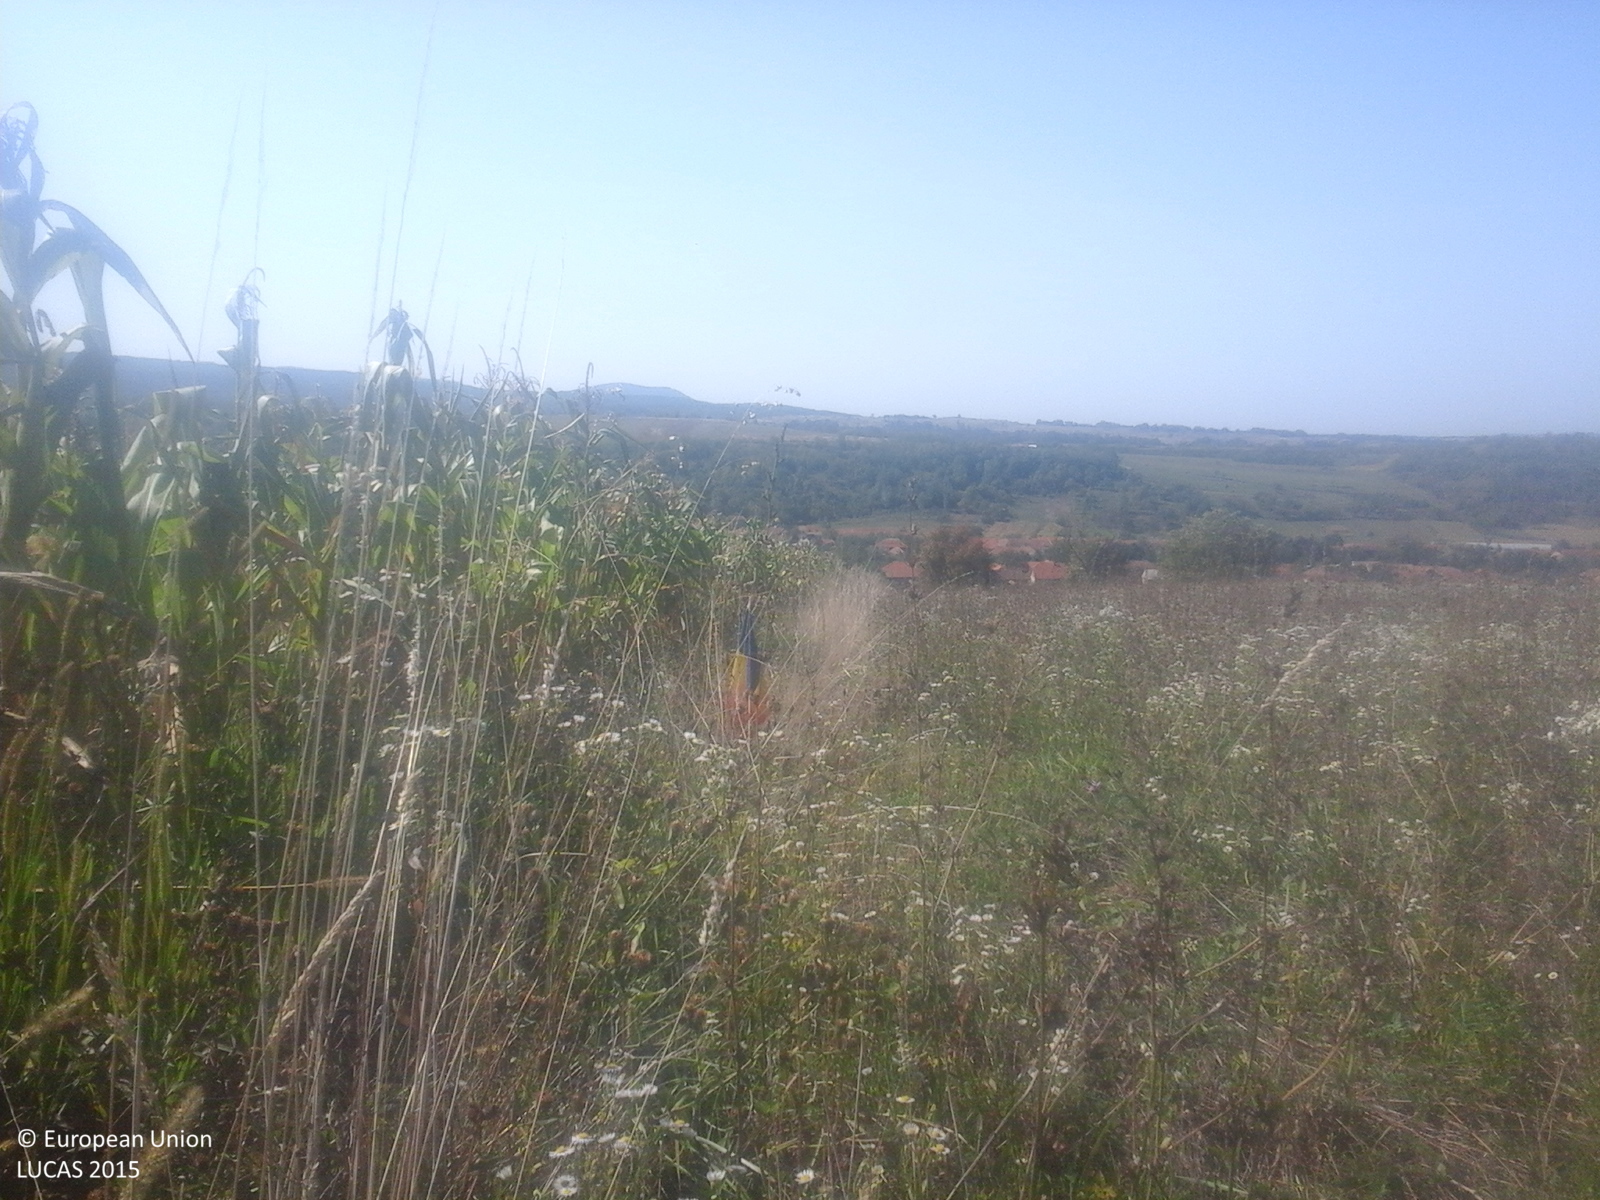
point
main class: Grassland
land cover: Grassland without tree/shrub cover
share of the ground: > 75 %
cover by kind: herbaceous plants 100 %
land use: Agriculture (excluding fallow land and kitchen gardens)
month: September
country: RO
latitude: 46.6379
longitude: 22.3160
